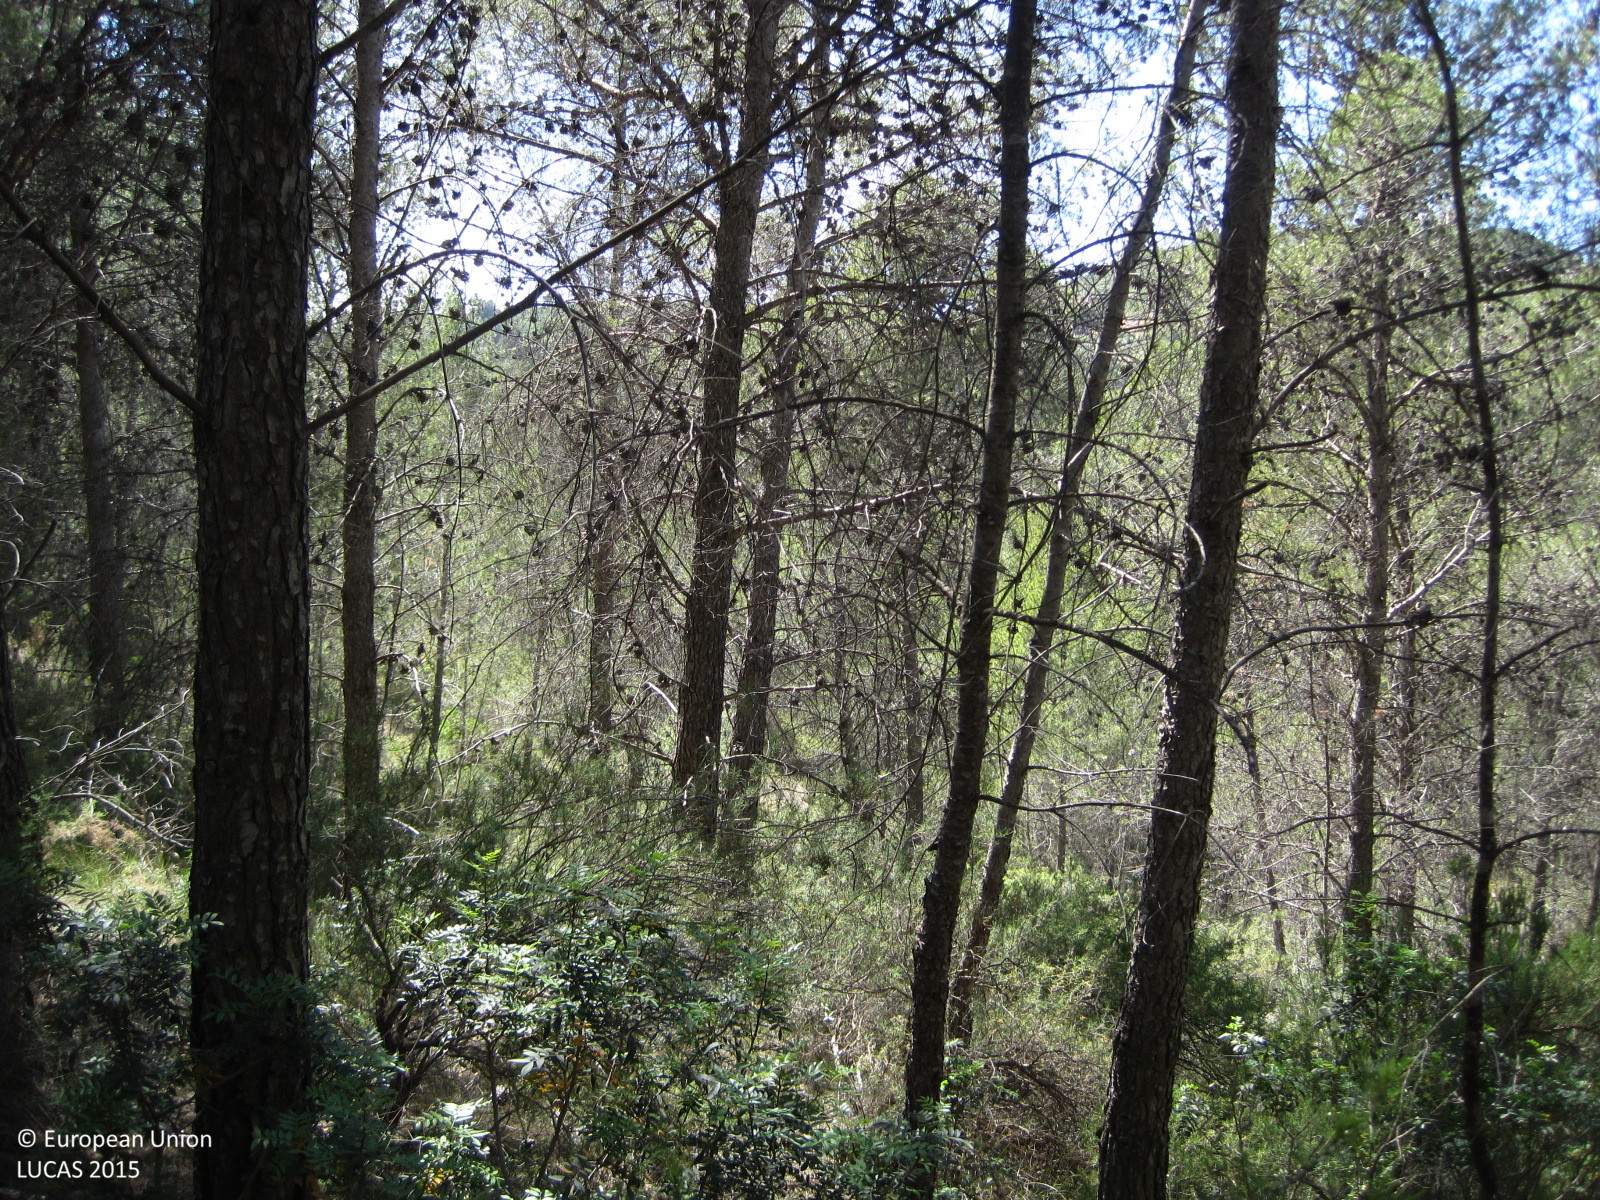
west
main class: Woodland
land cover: Pine dominated coniferous woodland
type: coniferous forest of the mediterranean region
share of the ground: > 75 %
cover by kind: coniferous forest trees 90 %, shrubs 10 %
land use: Semi-natural and natural areas not in use
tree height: > 5 m
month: May
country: ES
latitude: 39.3716
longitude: -0.8517
